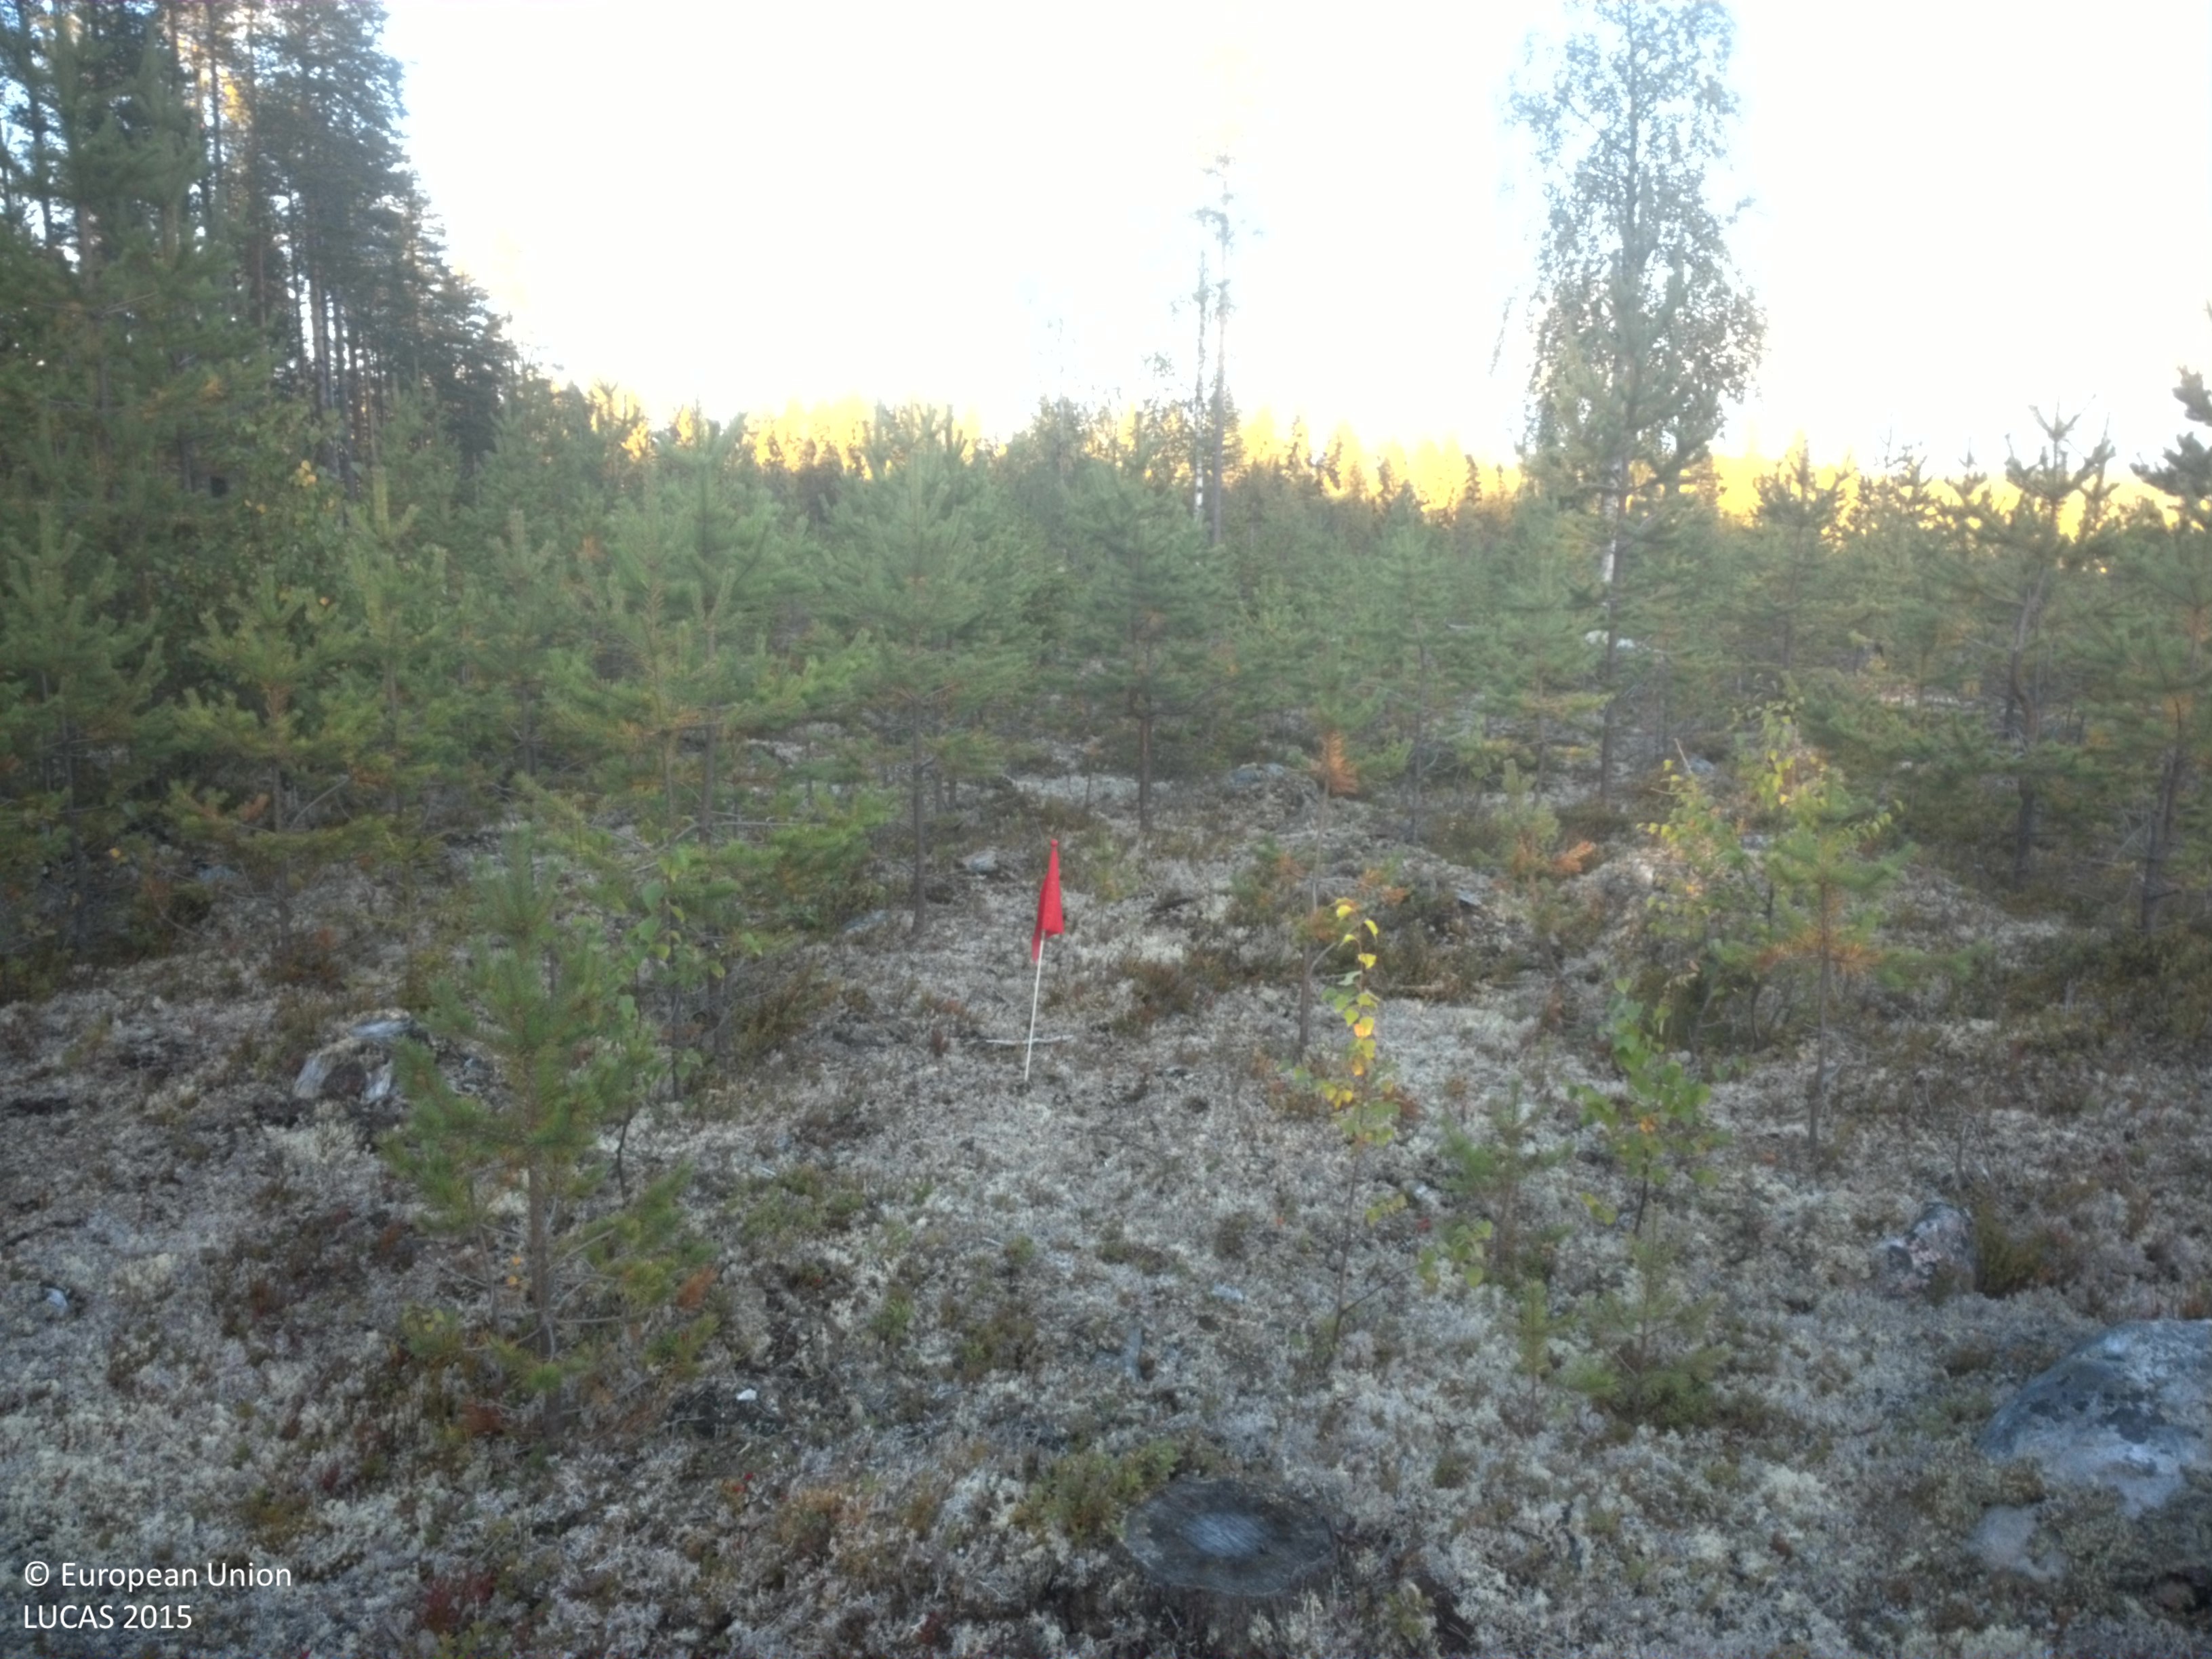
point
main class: Woodland
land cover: Pine dominated coniferous woodland
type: boreal forest
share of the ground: 25 - 50 %
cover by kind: coniferous forest trees 40 %, shrubs 30 %, lichens and mosses 30 %
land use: Forestry
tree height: > 5 m
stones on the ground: > 50 %
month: September
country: SE
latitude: 64.3923
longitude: 19.6991
